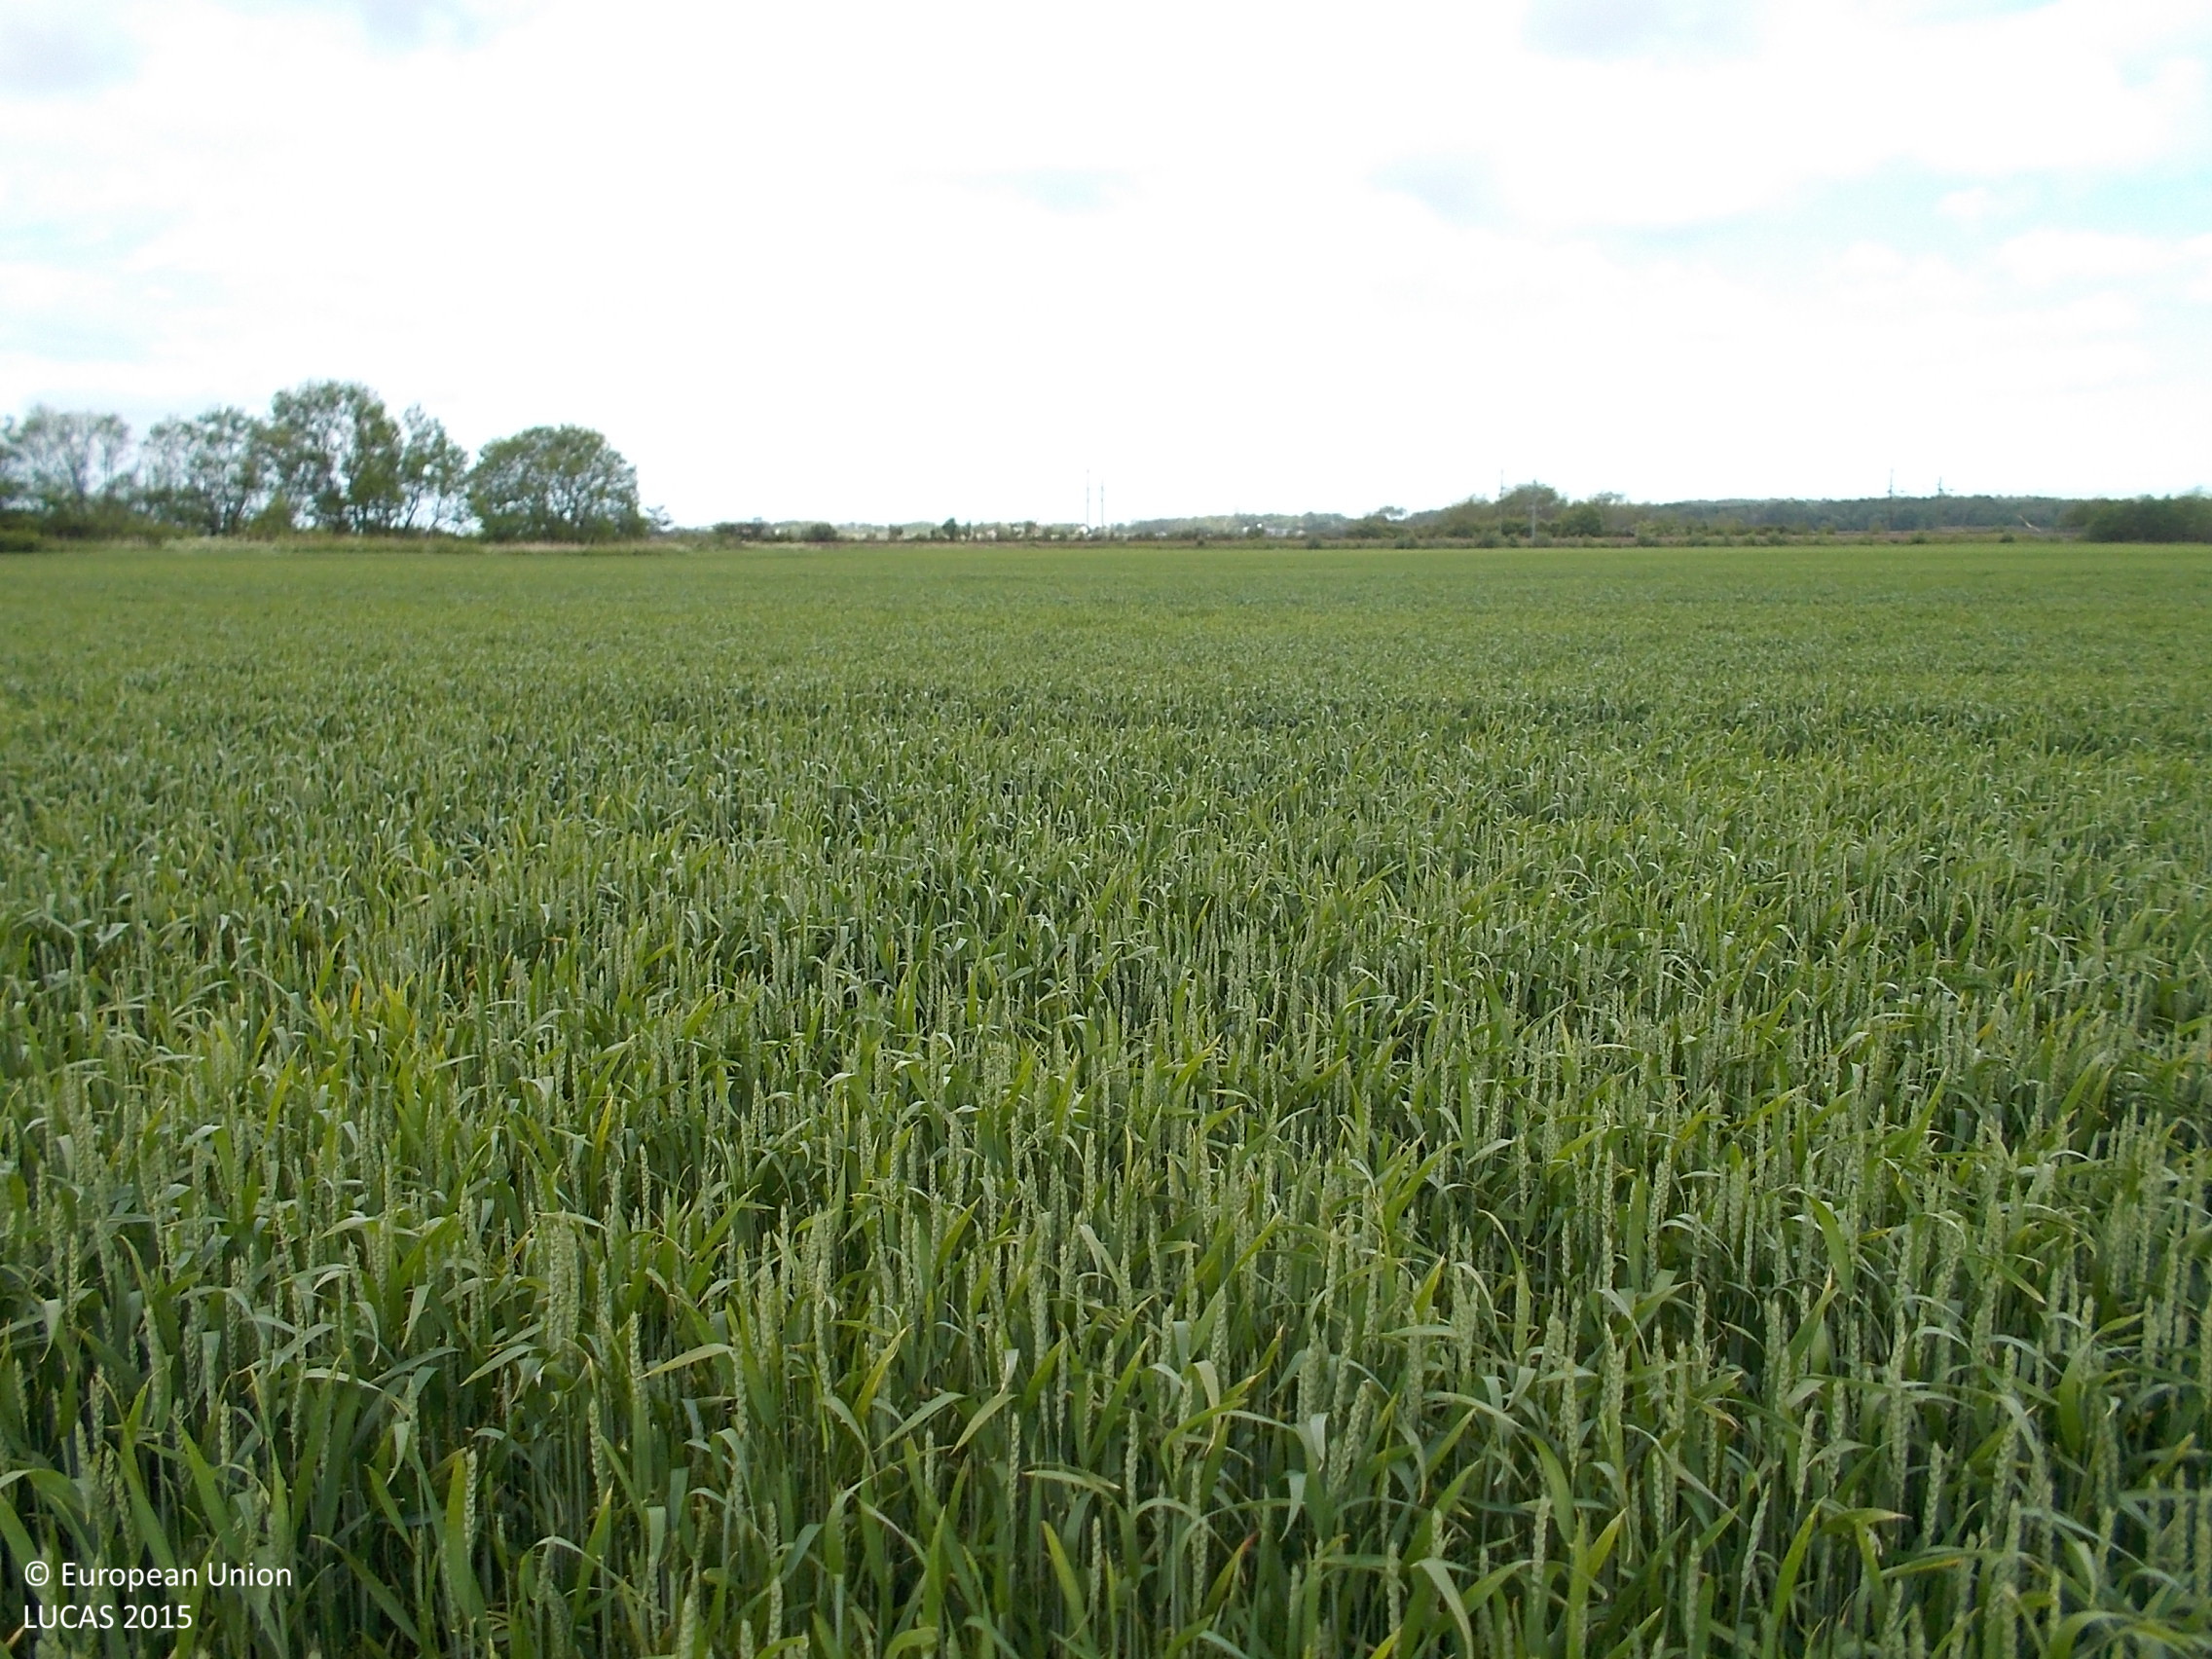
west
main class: Cropland
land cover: Common wheat
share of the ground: > 75 %
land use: Agriculture (excluding fallow land and kitchen gardens)
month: June
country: SE
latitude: 57.1391
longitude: 12.2607
